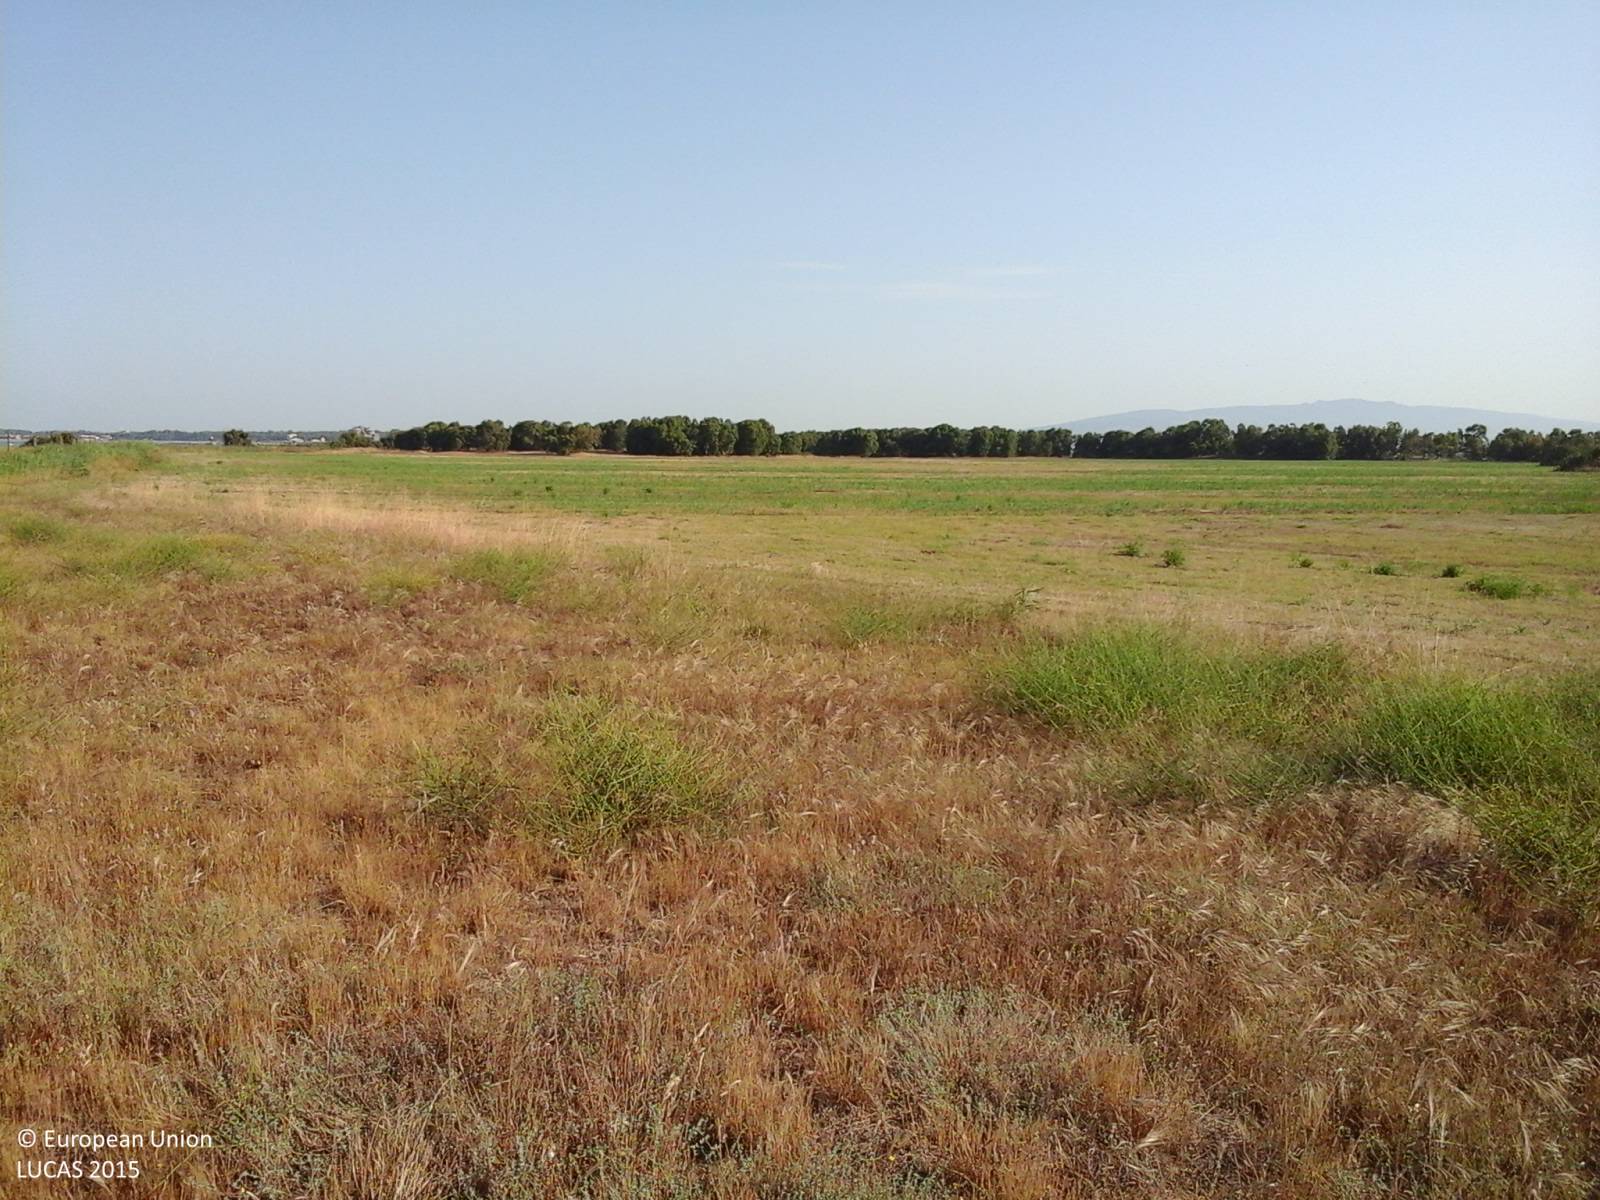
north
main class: Grassland
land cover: Grassland without tree/shrub cover
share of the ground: > 75 %
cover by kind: herbaceous plants 100 %
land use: Agriculture (excluding fallow land and kitchen gardens)
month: June
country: IT
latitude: 39.8763
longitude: 8.5466
